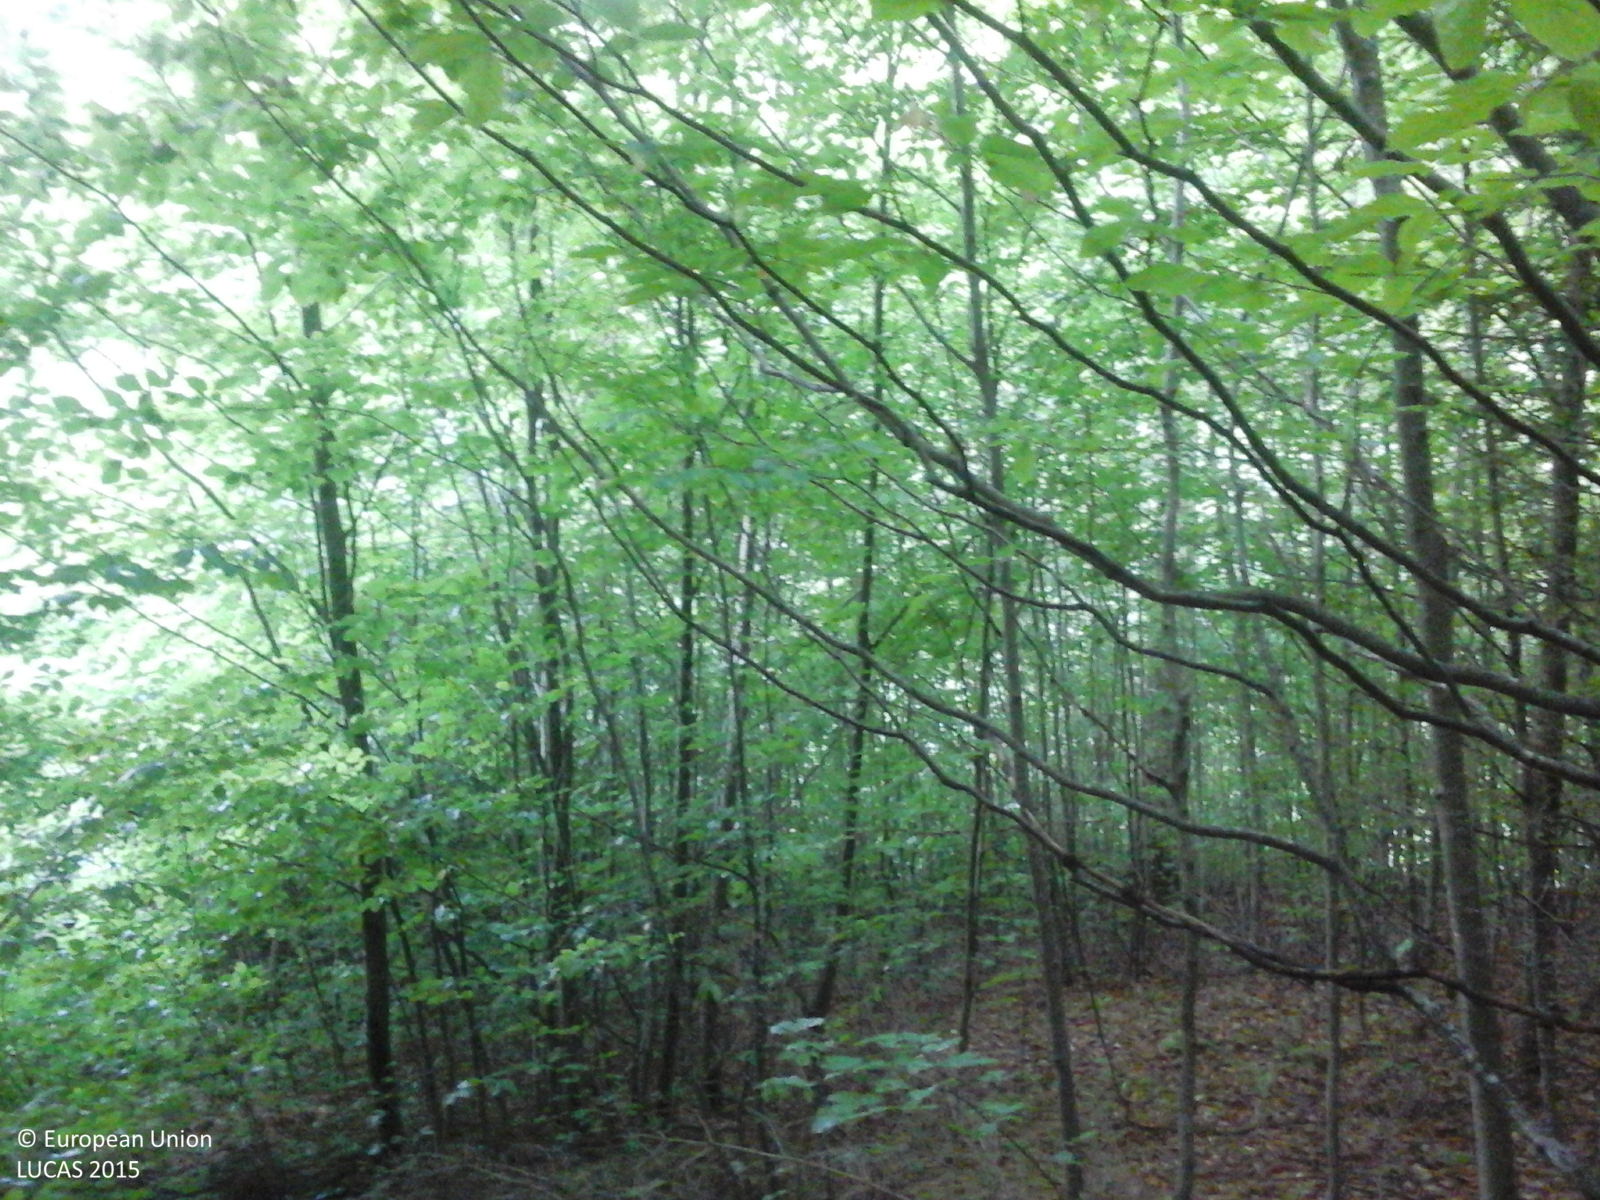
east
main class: Woodland
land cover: Broadleaved woodland
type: beech forest
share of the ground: > 75 %
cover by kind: broadleaved forest trees 85 %, coniferous forest trees 15 %
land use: Forestry
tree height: > 5 m
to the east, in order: Broadleaved woodland; Grass margins; Rivers and streams; Grass margins; Broadleaved woodland
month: May
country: RO
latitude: 45.8422
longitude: 25.3320
